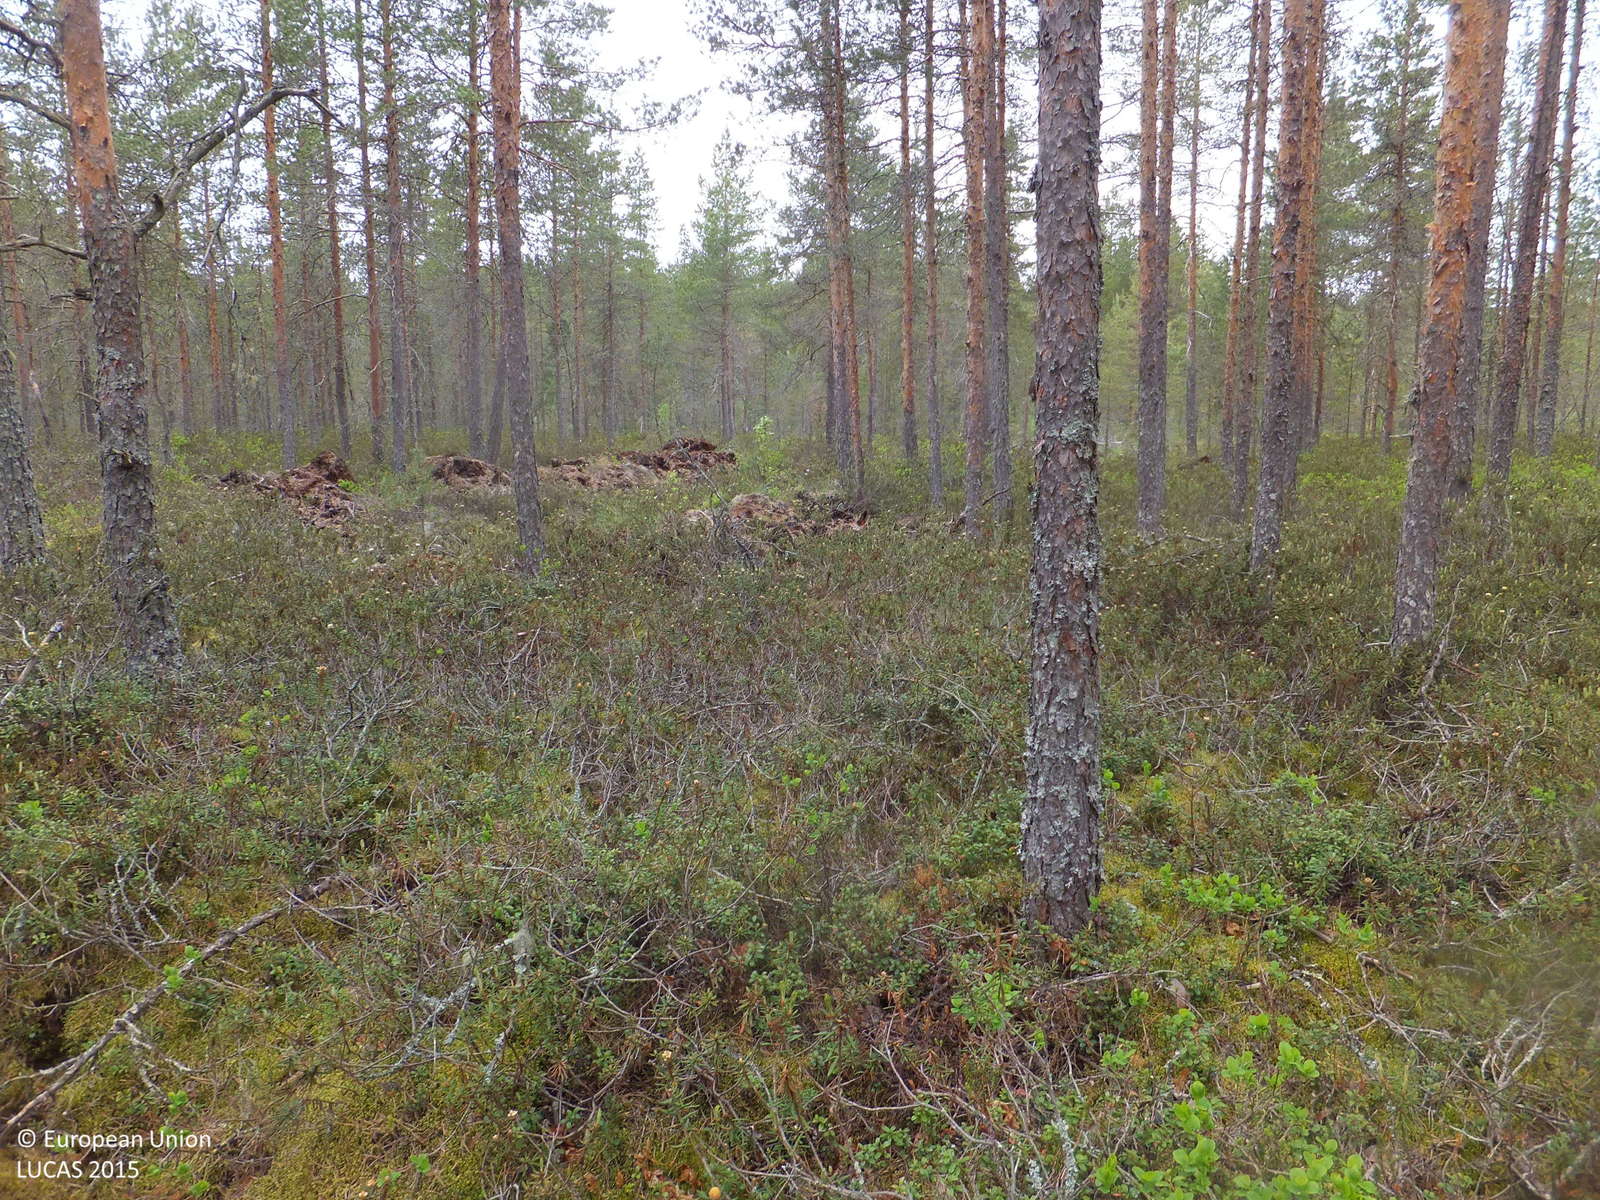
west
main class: Woodland
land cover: Pine dominated coniferous woodland
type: boreal forest
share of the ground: > 75 %
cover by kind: coniferous forest trees 80 %, shrubs 10 %, lichens and mosses 10 %
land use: Forestry
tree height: > 5 m
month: June
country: FI
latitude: 63.2589
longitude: 22.7418
